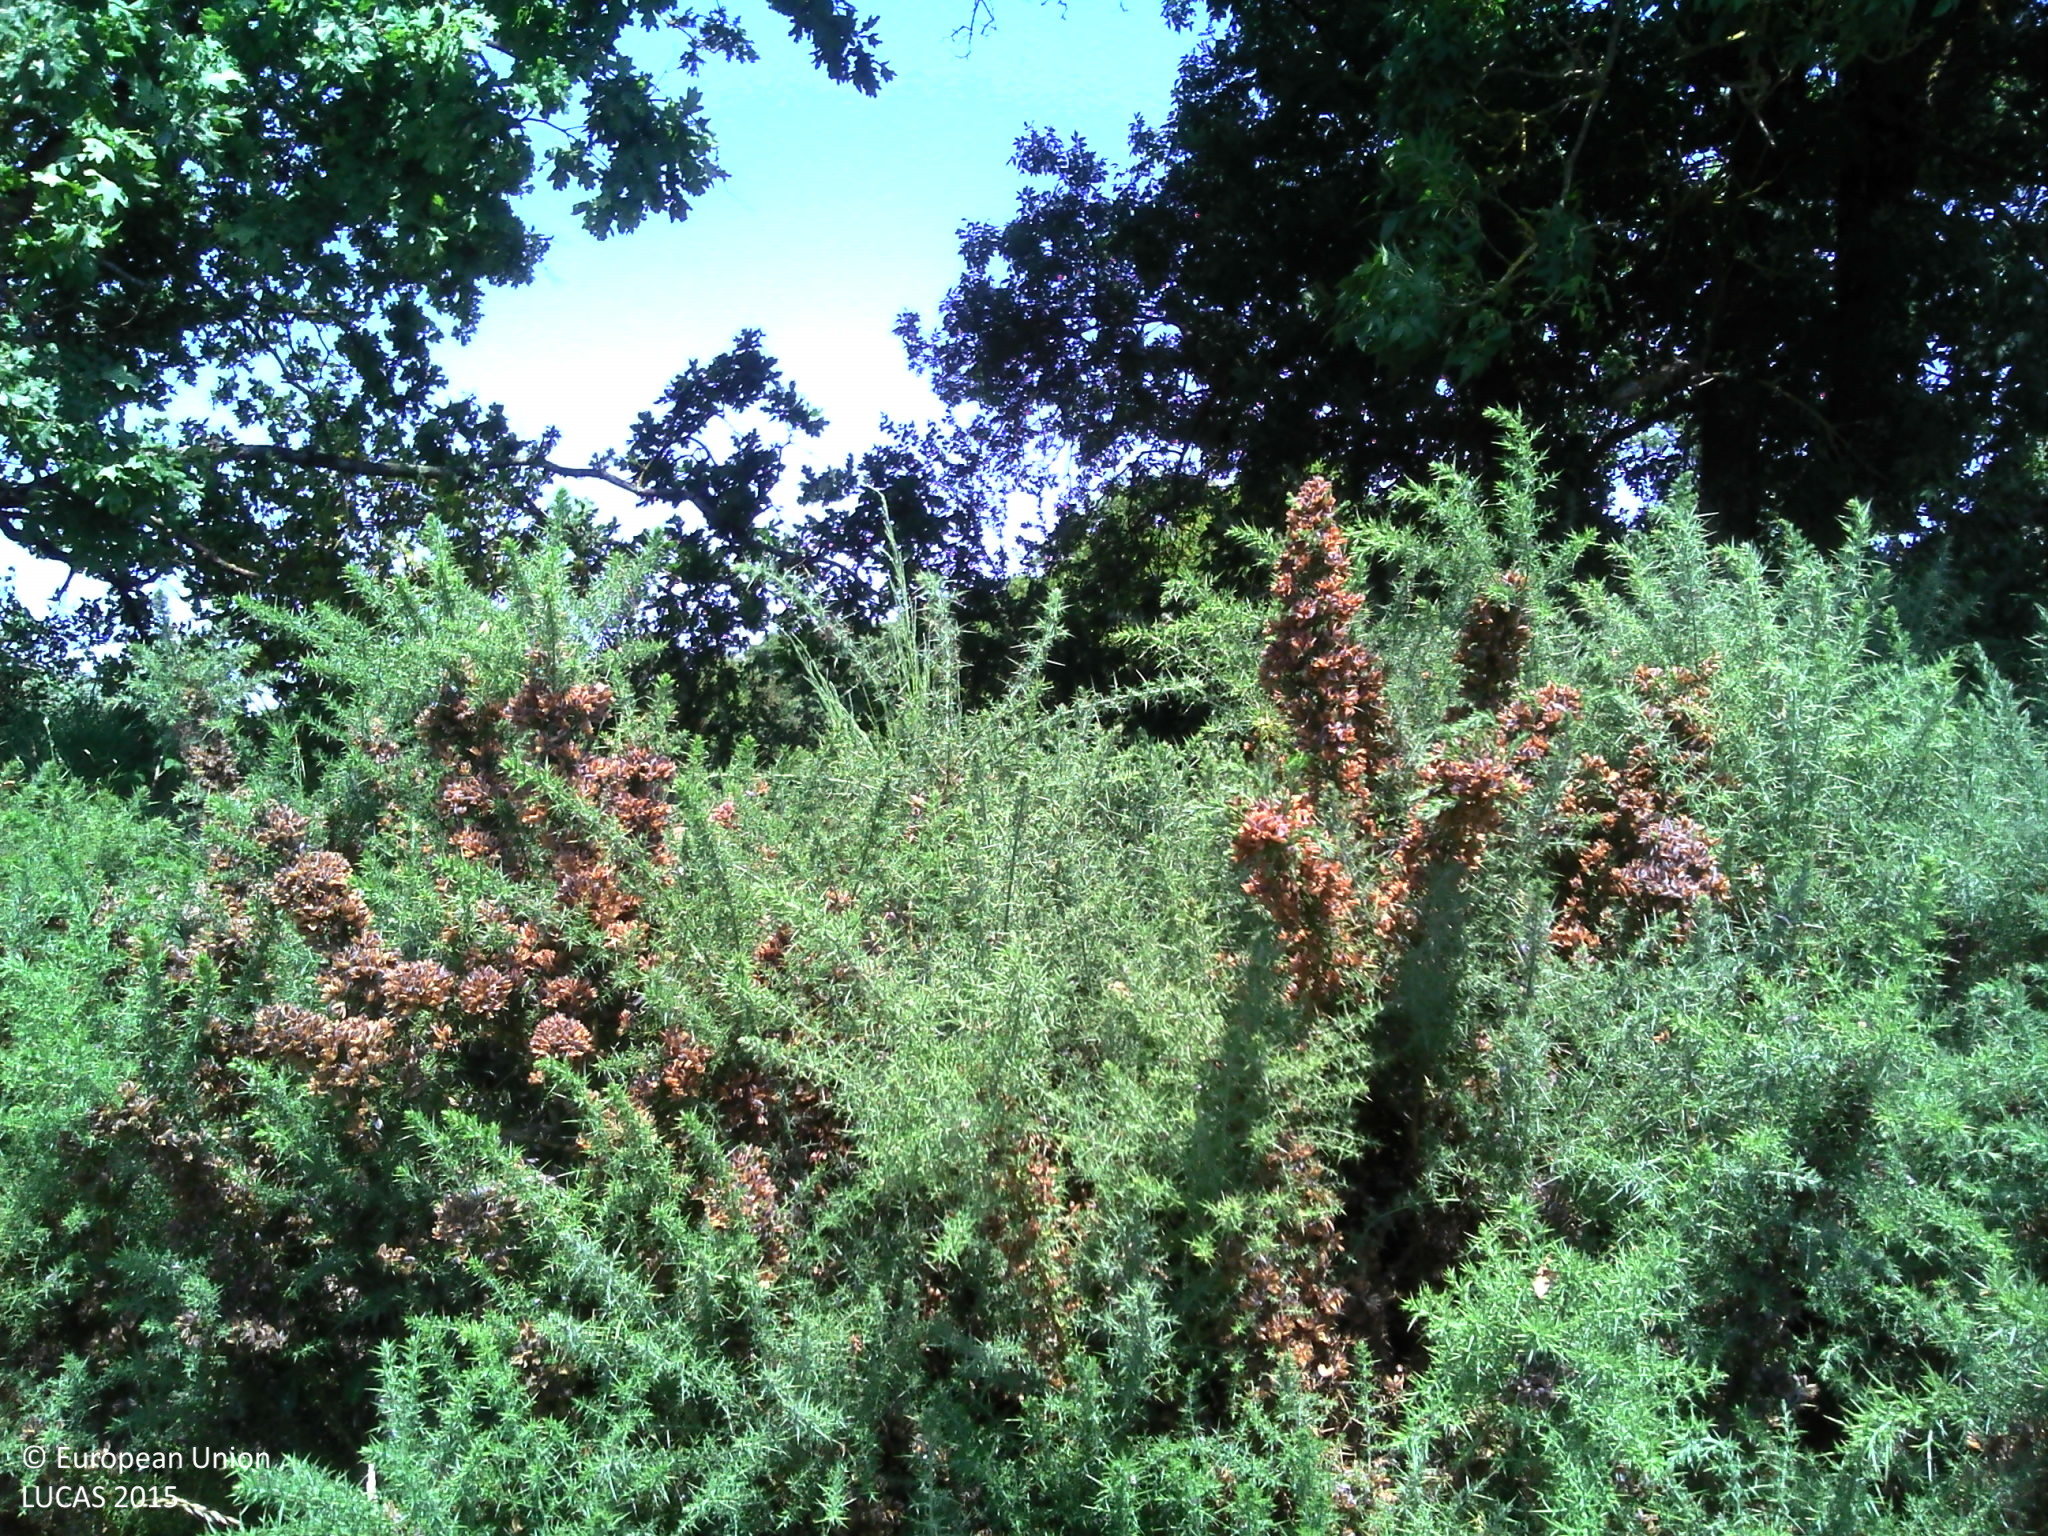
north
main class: Grassland
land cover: Grassland without tree/shrub cover
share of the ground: > 75 %
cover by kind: herbaceous plants 100 %
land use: Agriculture (excluding fallow land and kitchen gardens)
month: June
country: FR
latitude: 47.1637
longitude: -2.0127
